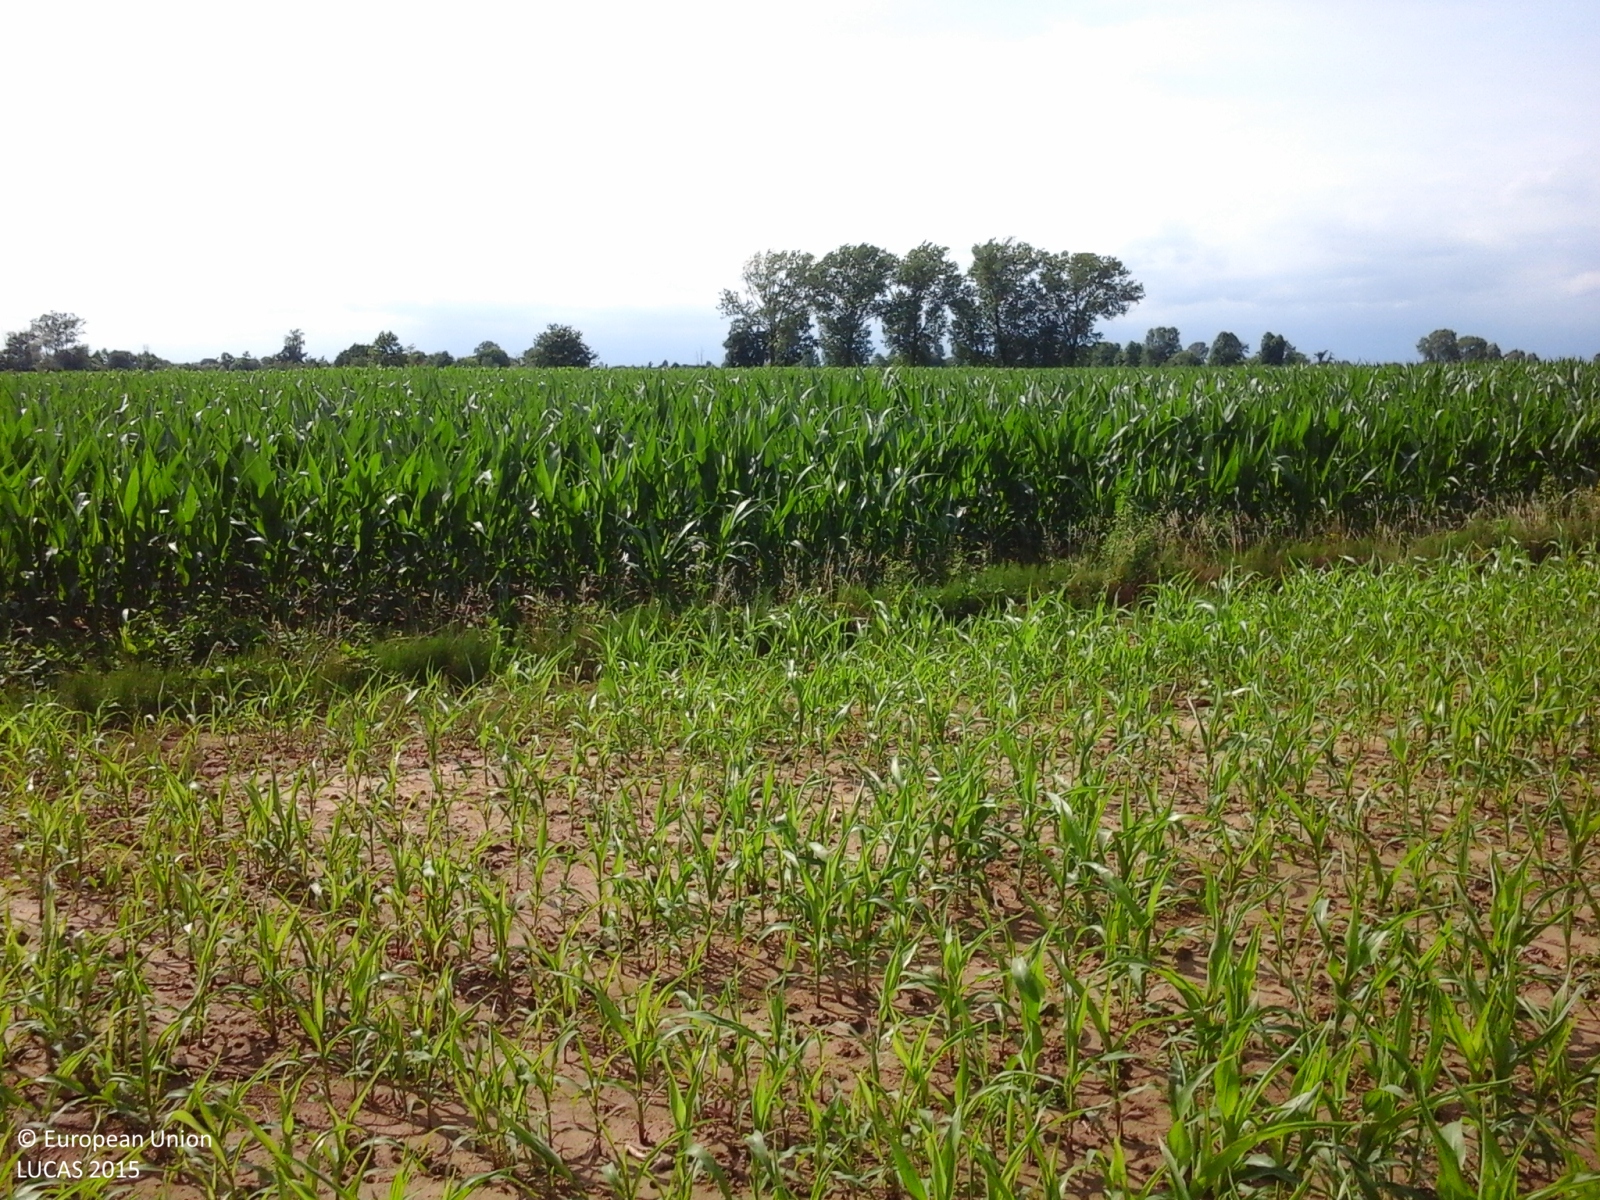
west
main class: Cropland
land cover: Other cereals
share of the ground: 50 - 75 %
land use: Agriculture (excluding fallow land and kitchen gardens)
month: June
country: IT
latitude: 45.7928
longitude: 12.7622
